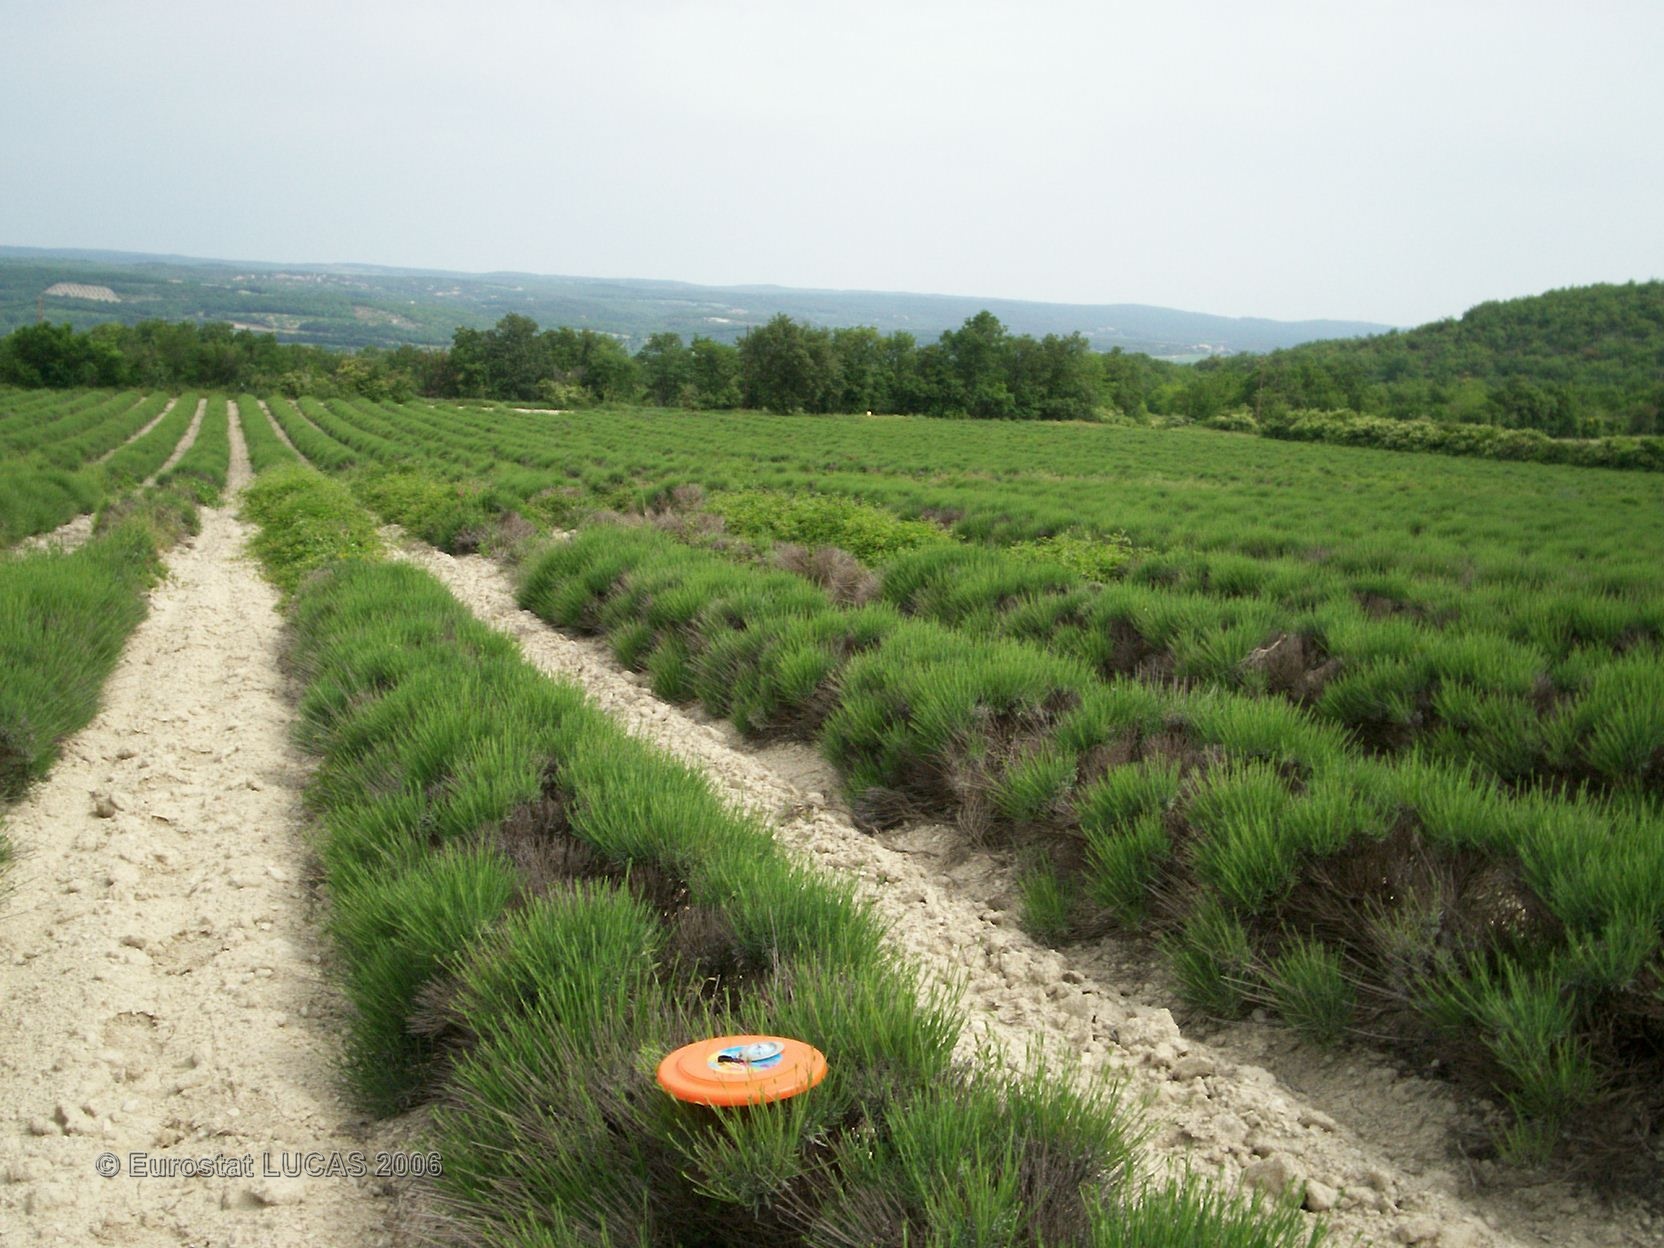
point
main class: Cropland
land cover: Permanent industrial crops
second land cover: Bare land
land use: Agriculture (excluding fallow land and kitchen gardens)
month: May
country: FR
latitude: 44.4032
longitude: 4.8466
